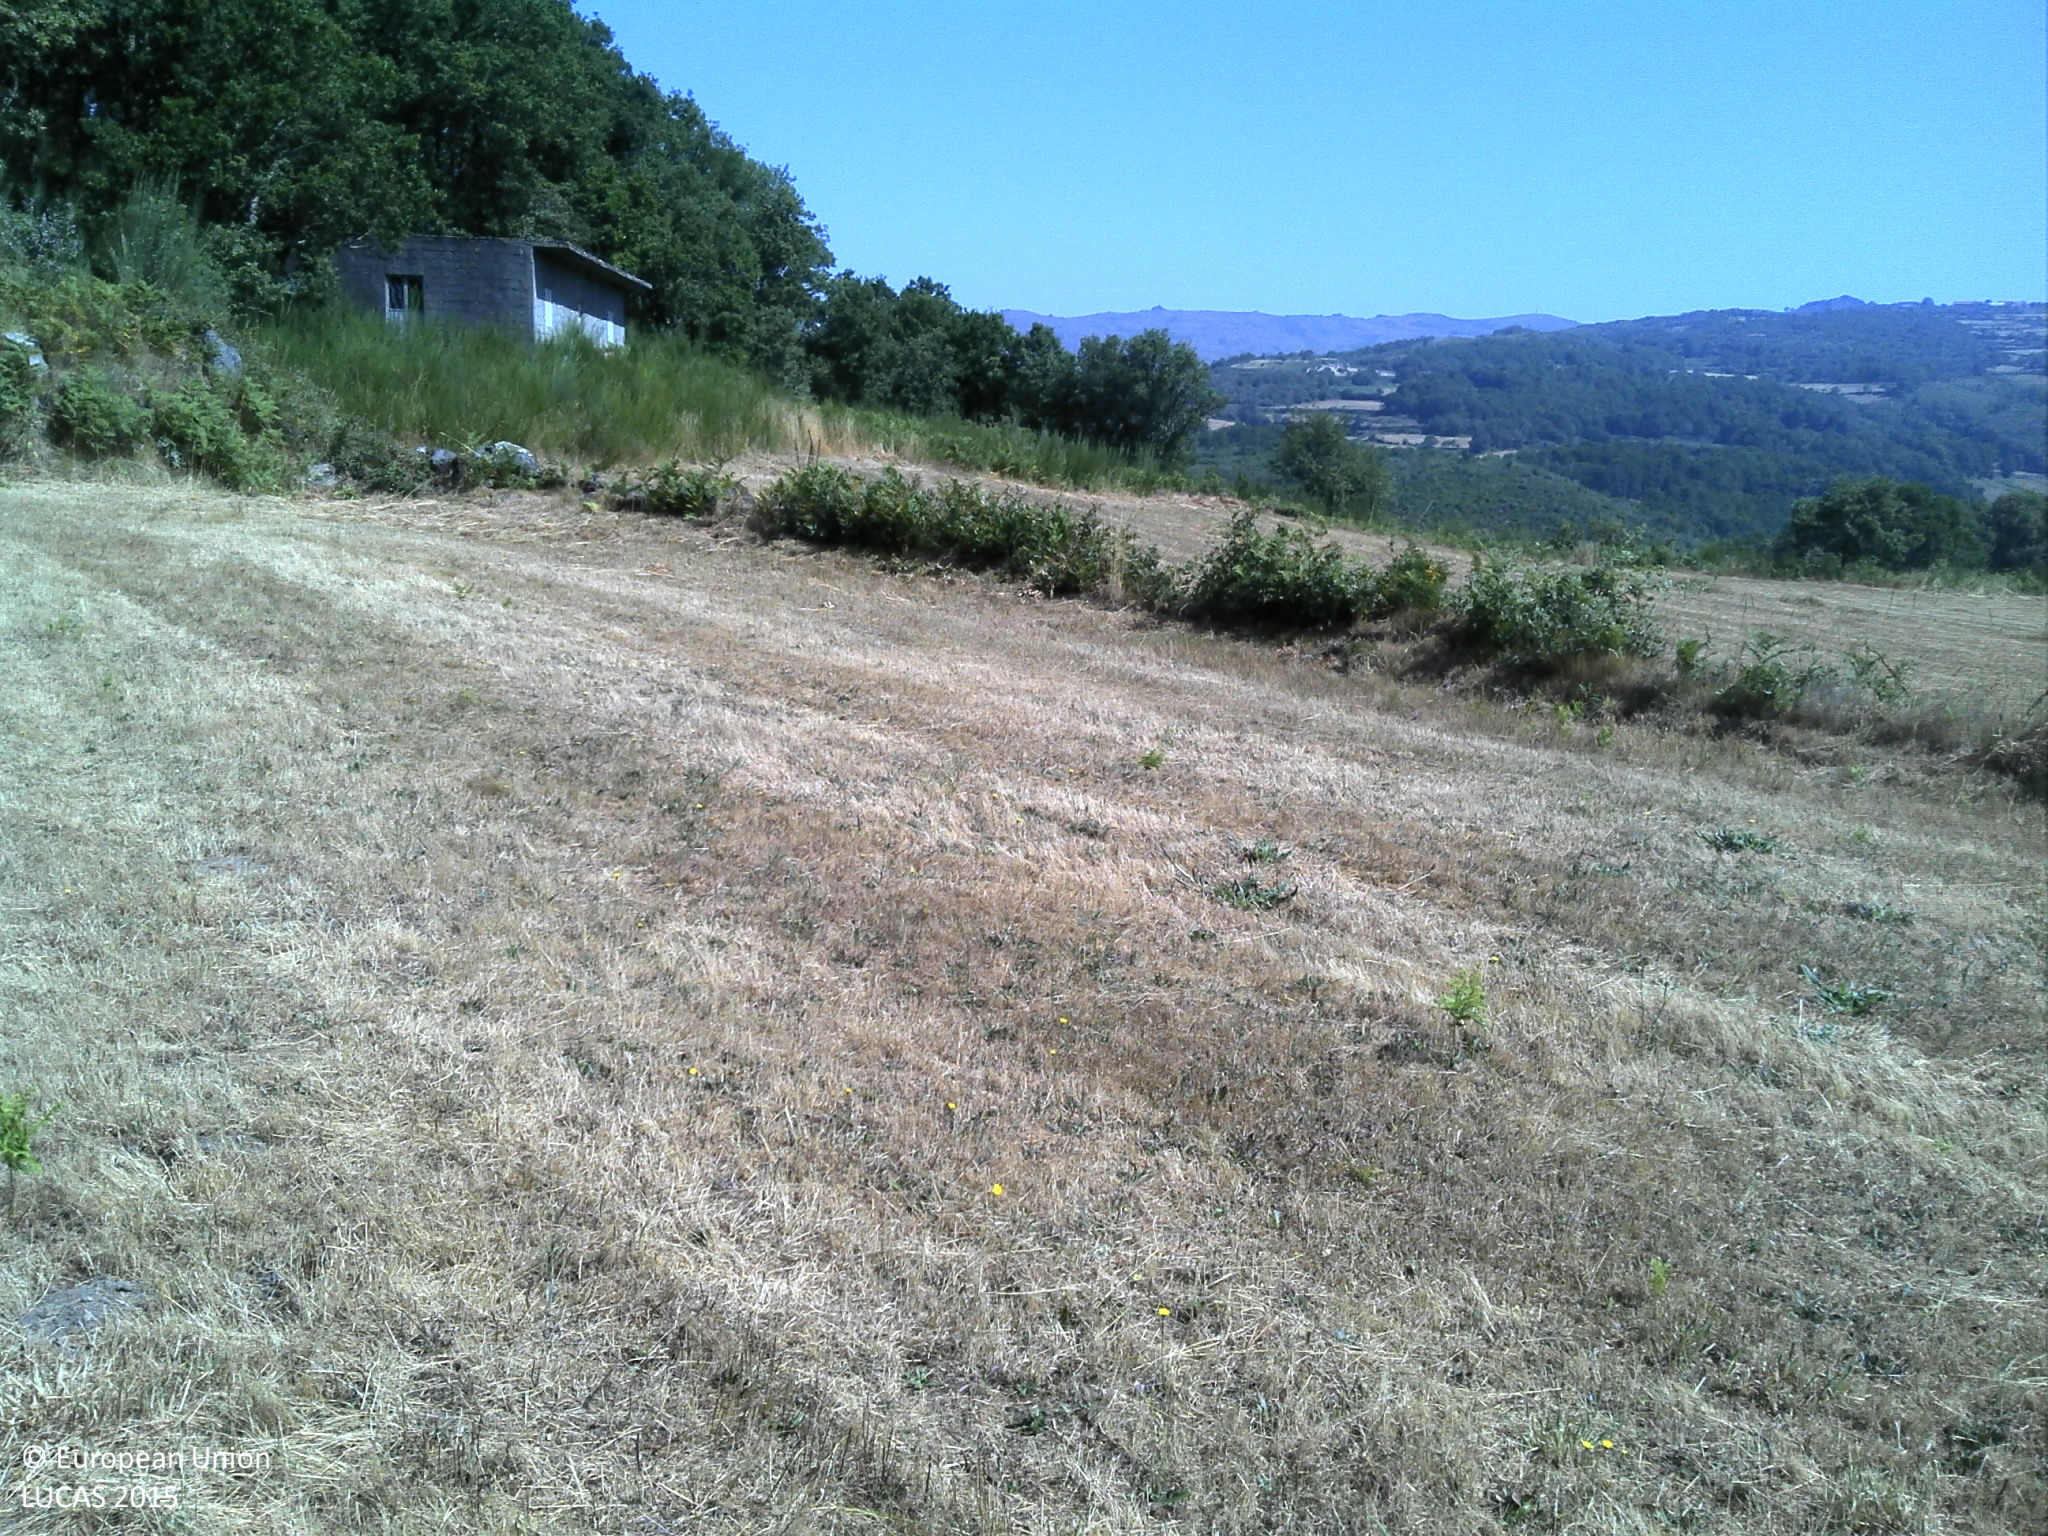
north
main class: Grassland
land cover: Grassland without tree/shrub cover
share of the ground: > 75 %
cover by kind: herbaceous plants 90 %, unconsolidated bare surface 10 %
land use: Agriculture (excluding fallow land and kitchen gardens)
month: July
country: PT
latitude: 41.7755
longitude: -7.9367
